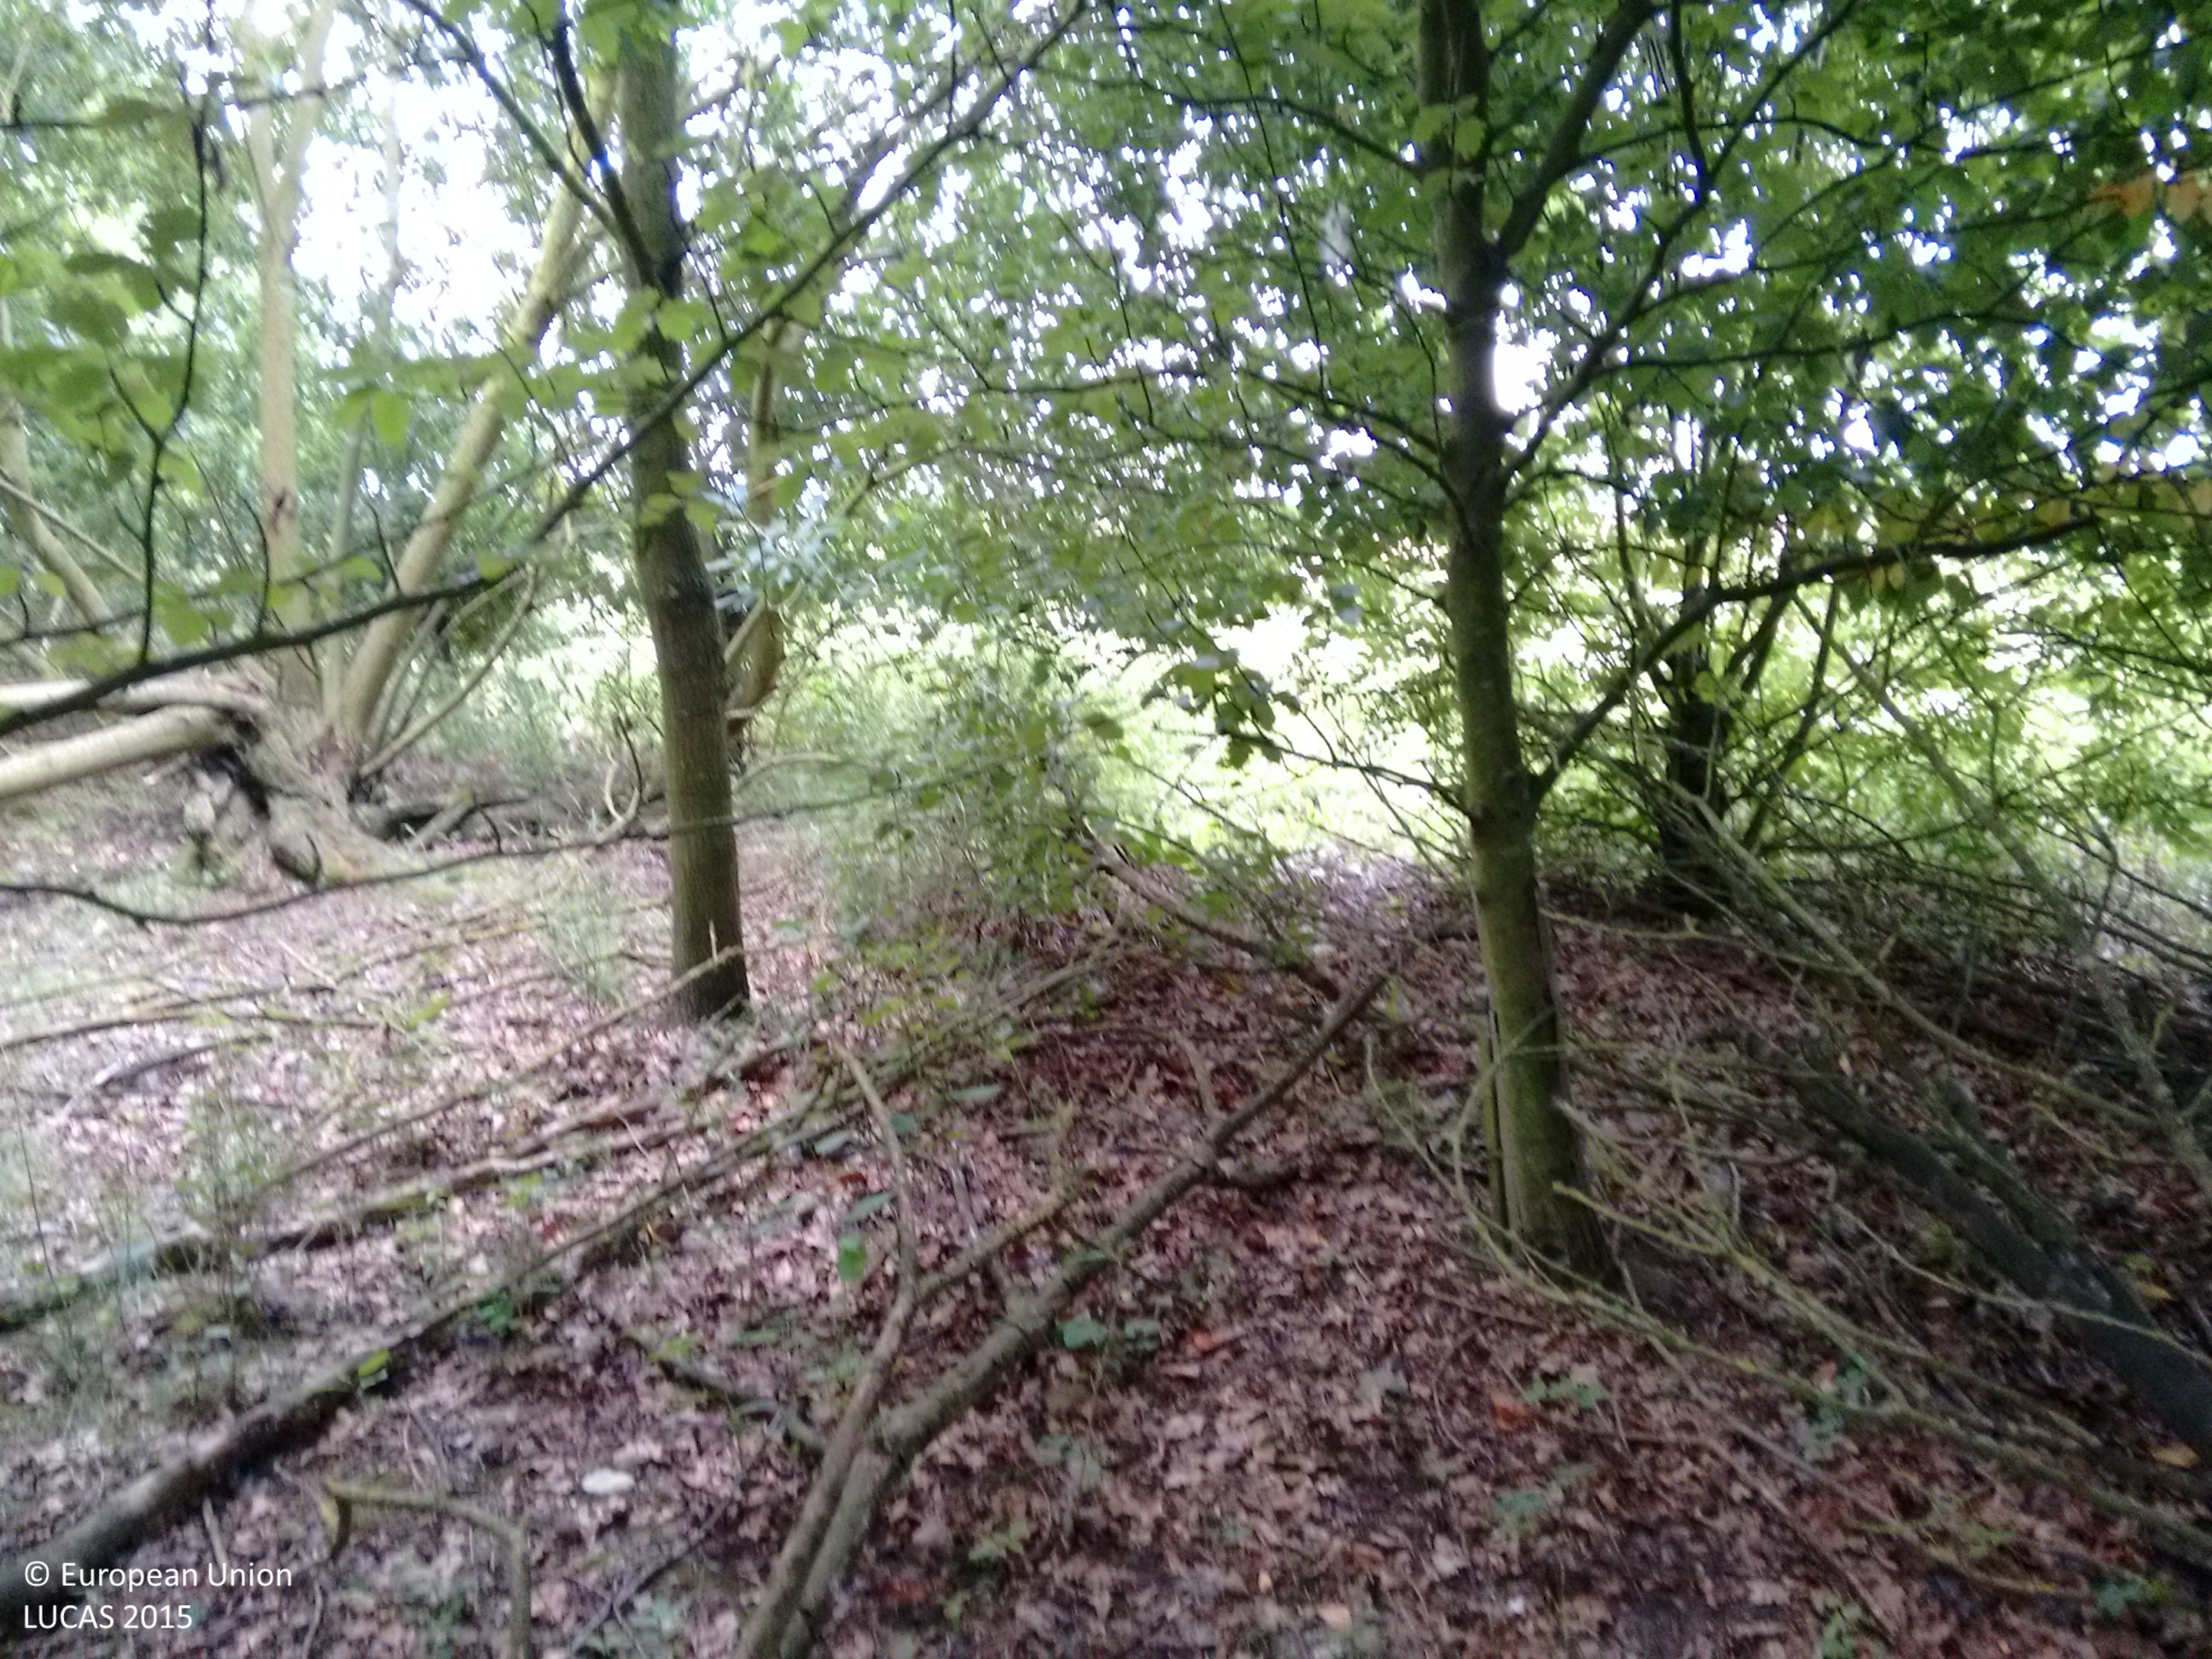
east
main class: Woodland
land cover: Other mixed woodland
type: exotic forest
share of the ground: > 75 %
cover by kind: broadleaved forest trees 60 %, coniferous forest trees 40 %
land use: Sport
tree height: > 5 m
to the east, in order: Other mixed woodland; Spontaneously vegetated surfaces; Dry pulses; Grass margins; Tracks
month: August
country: GB
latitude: 52.3794
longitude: 0.3190
